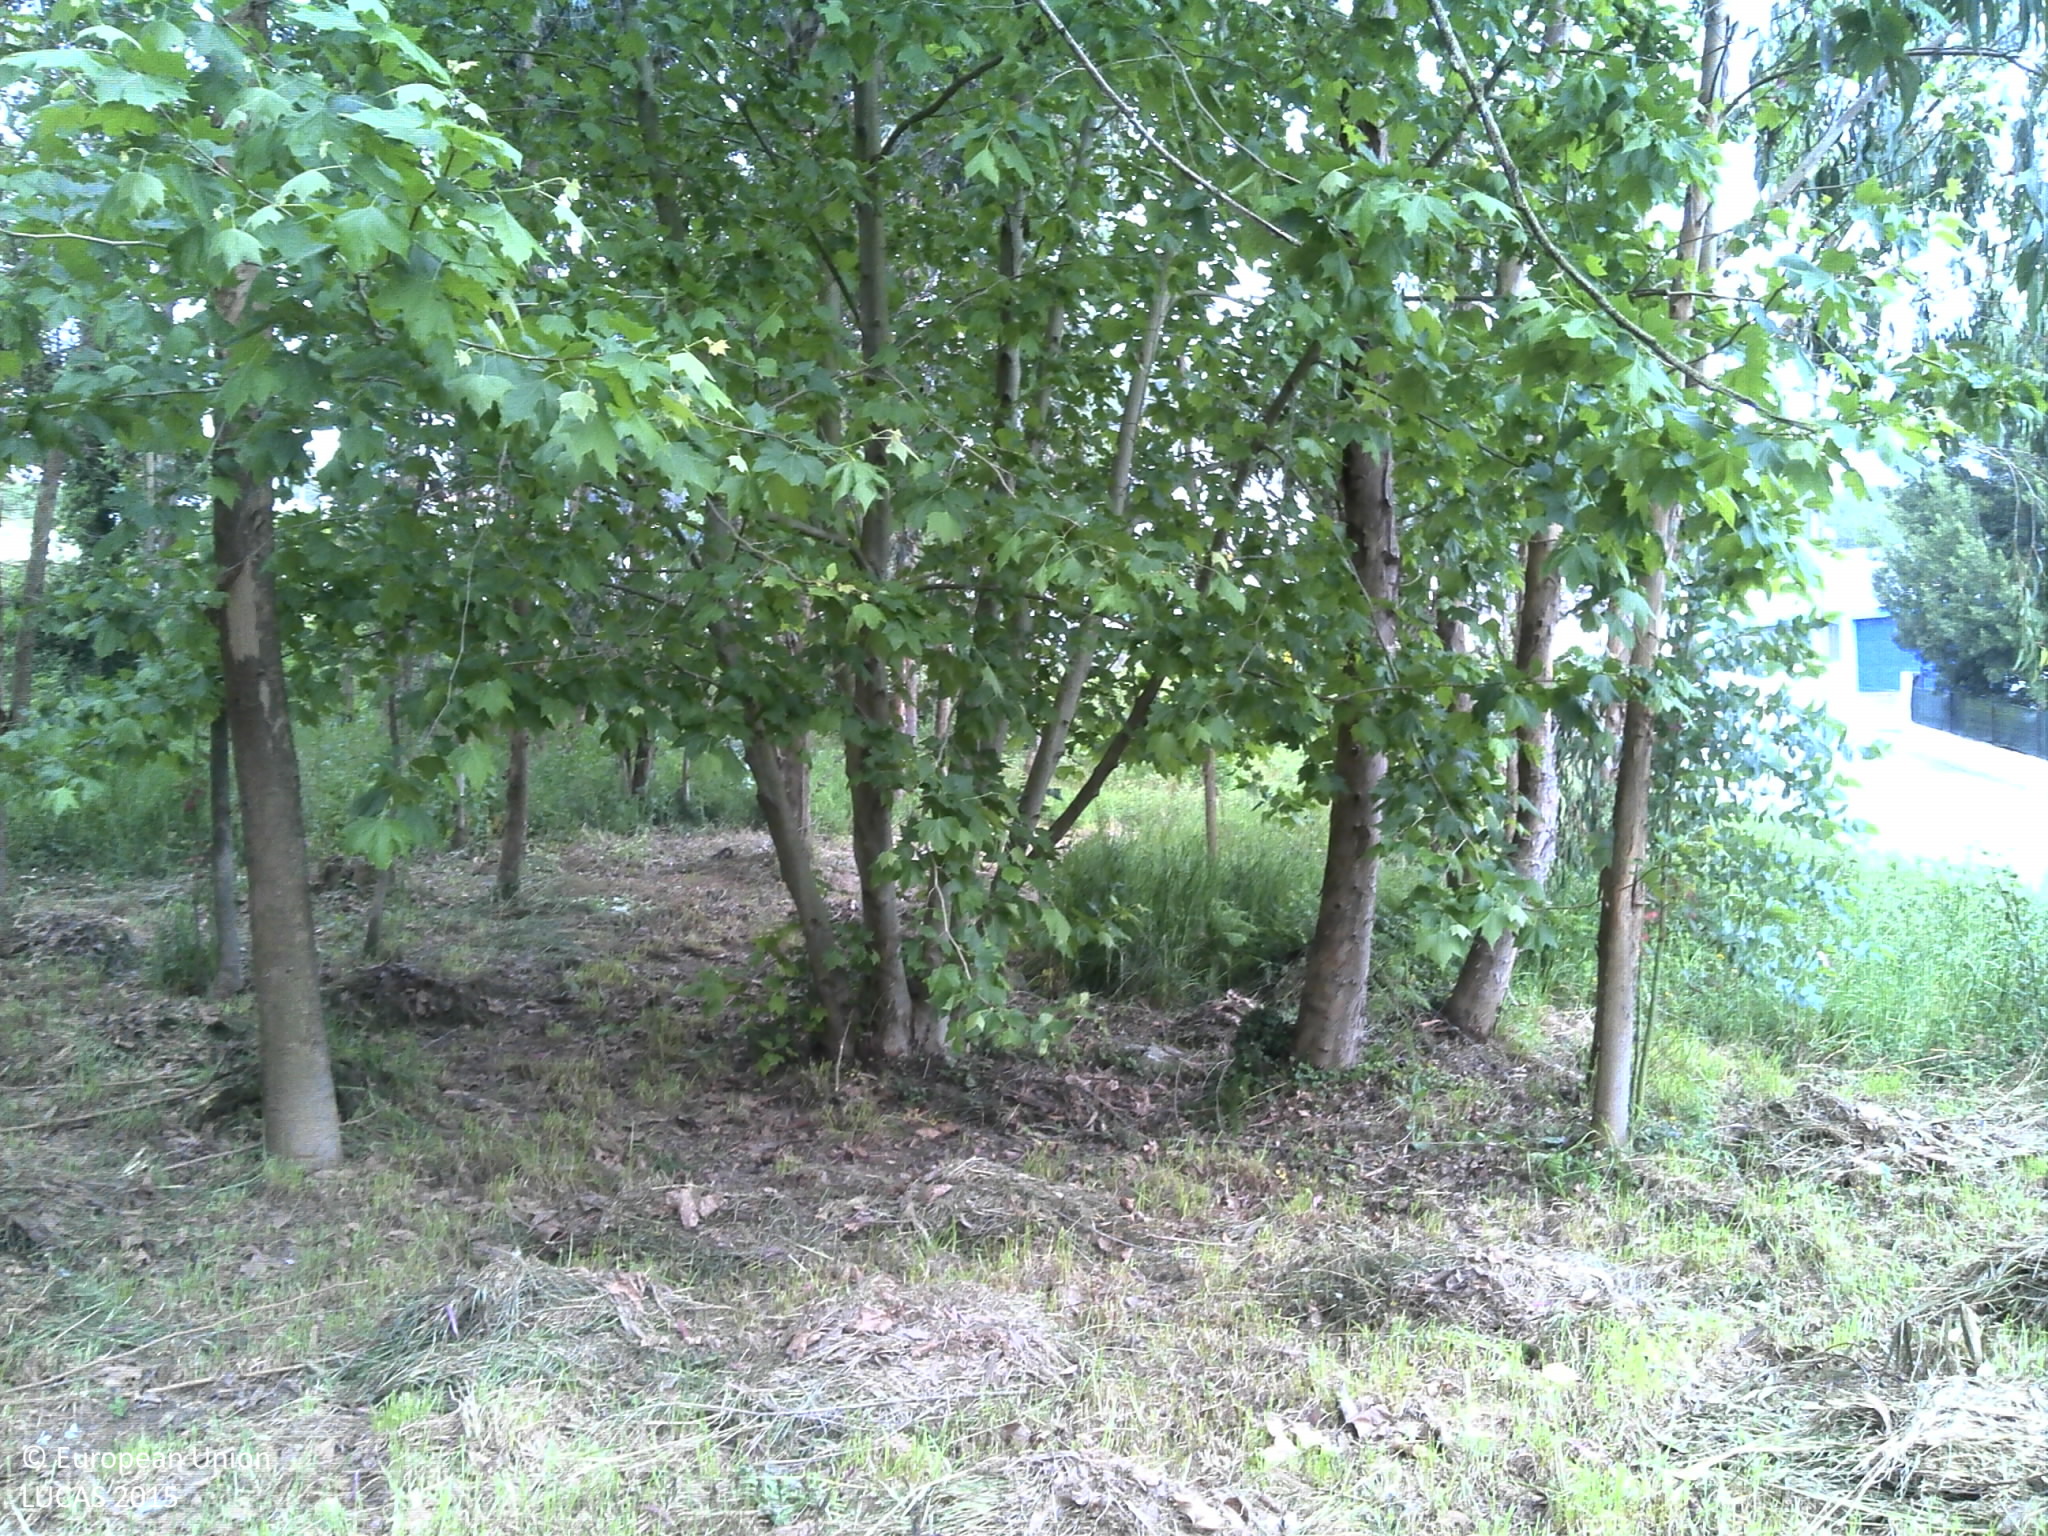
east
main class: Woodland
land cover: Broadleaved woodland
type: exotic forest
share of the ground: 50 - 75 %
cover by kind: broadleaved forest trees 75 %, herbaceous plants 15 %, shrubs 10 %
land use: Forestry
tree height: > 5 m
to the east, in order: Broadleaved woodland; Grassland with sparse tree/shrub cover; Artificial constructions in urban areas; Broadleaved woodland; Artificial constructions in urban areas; Tracks
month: May
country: PT
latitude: 40.8893
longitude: -8.5303
